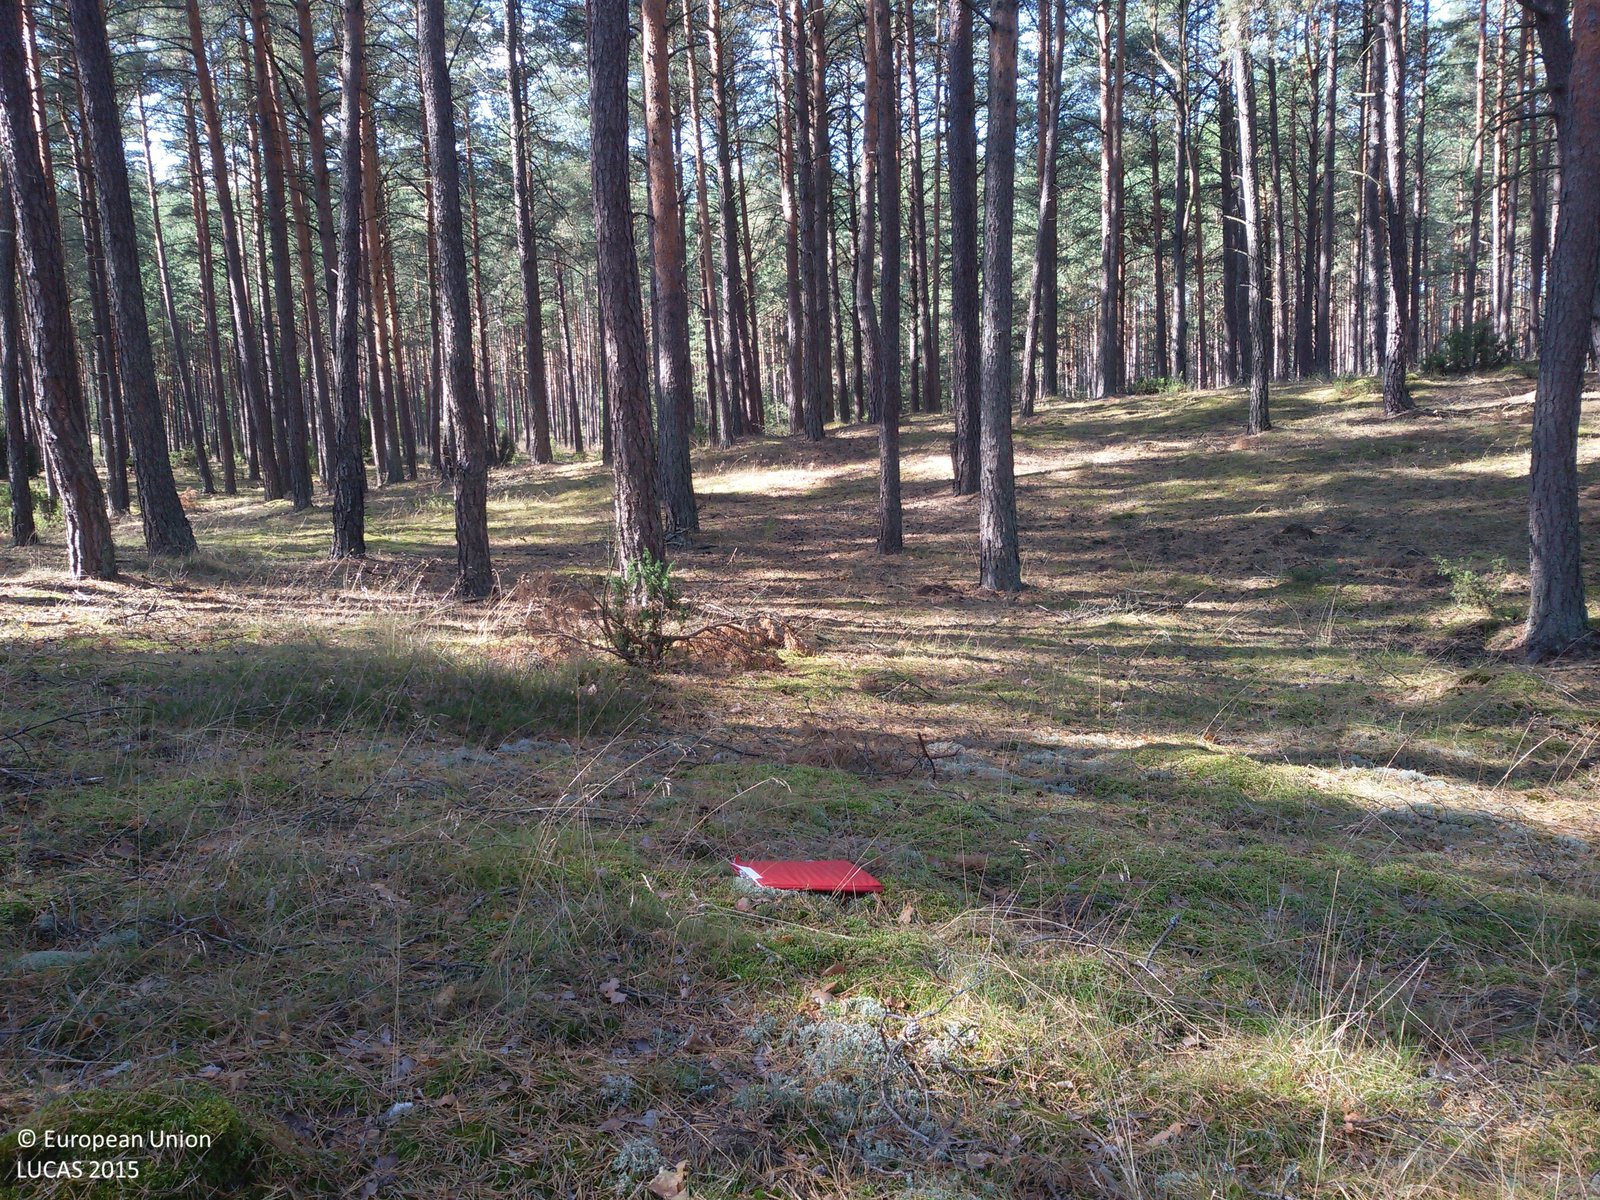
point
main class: Woodland
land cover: Pine dominated coniferous woodland
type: hemiboreal forest and nemoral coniferous forest and mixed broadleaved-coniferous forest
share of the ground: 50 - 75 %
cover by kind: coniferous forest trees 60 %, herbaceous plants 35 %, lichens and mosses 5 %
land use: Forestry
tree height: > 5 m
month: September
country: PL
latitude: 53.8915
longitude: 17.7884
